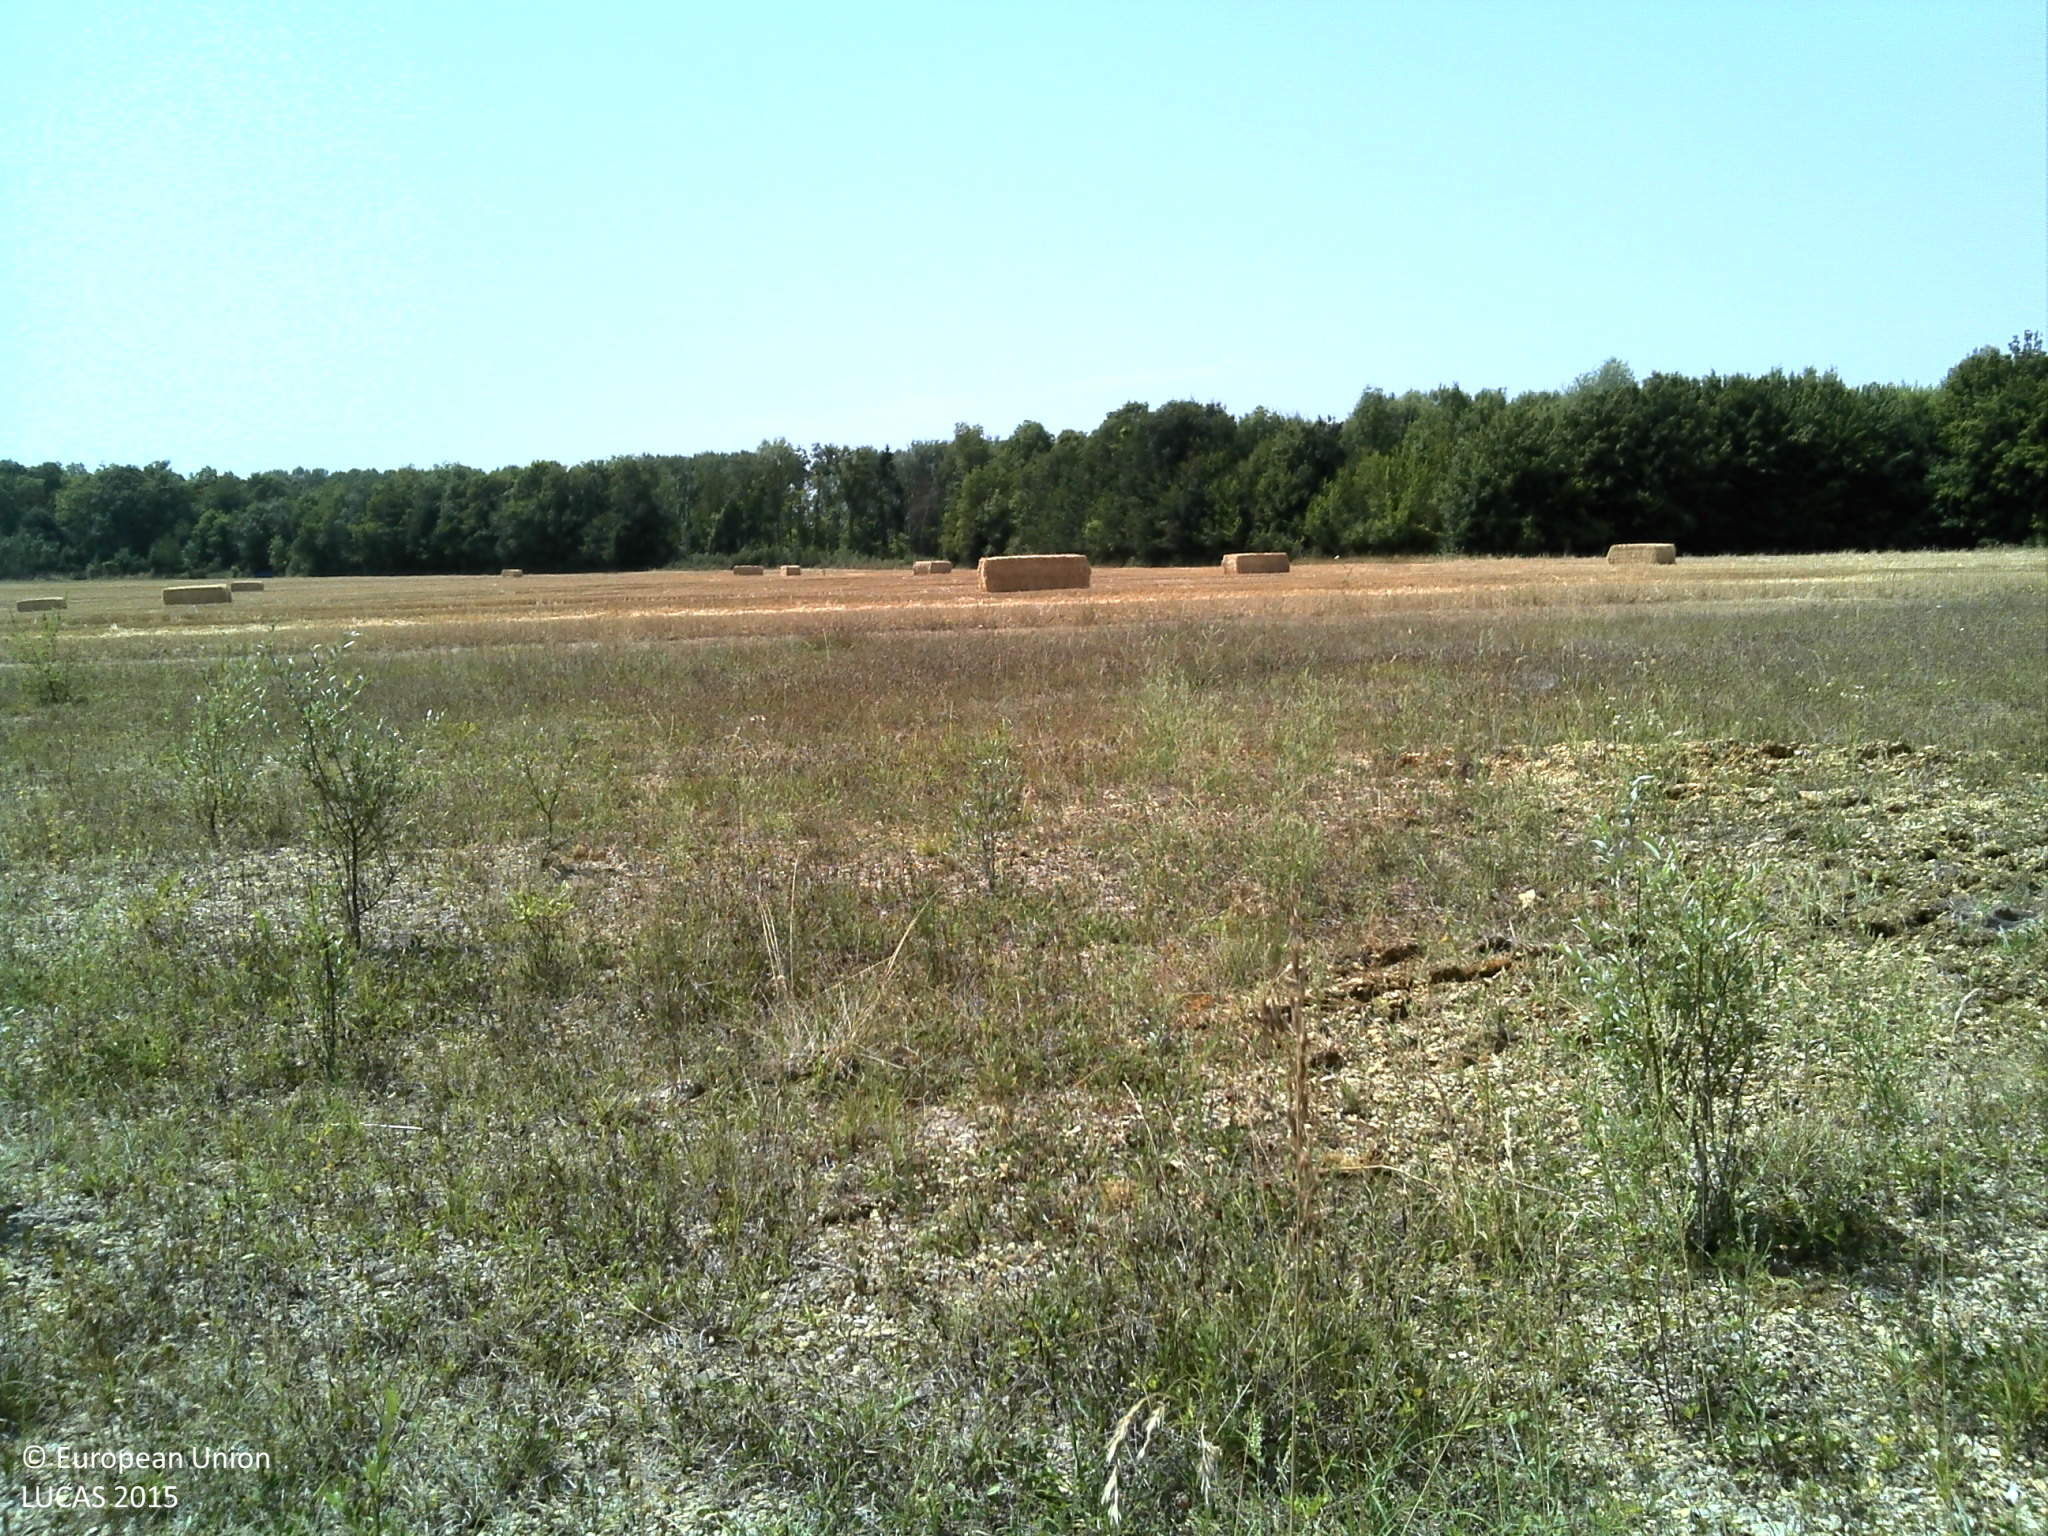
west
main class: Woodland
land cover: Broadleaved woodland
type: beech forest
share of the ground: > 75 %
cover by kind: broadleaved forest trees 85 %, coniferous forest trees 10 %, herbaceous plants 5 %
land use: Forestry
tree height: > 5 m
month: July
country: FR
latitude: 48.8441
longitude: 4.8879
